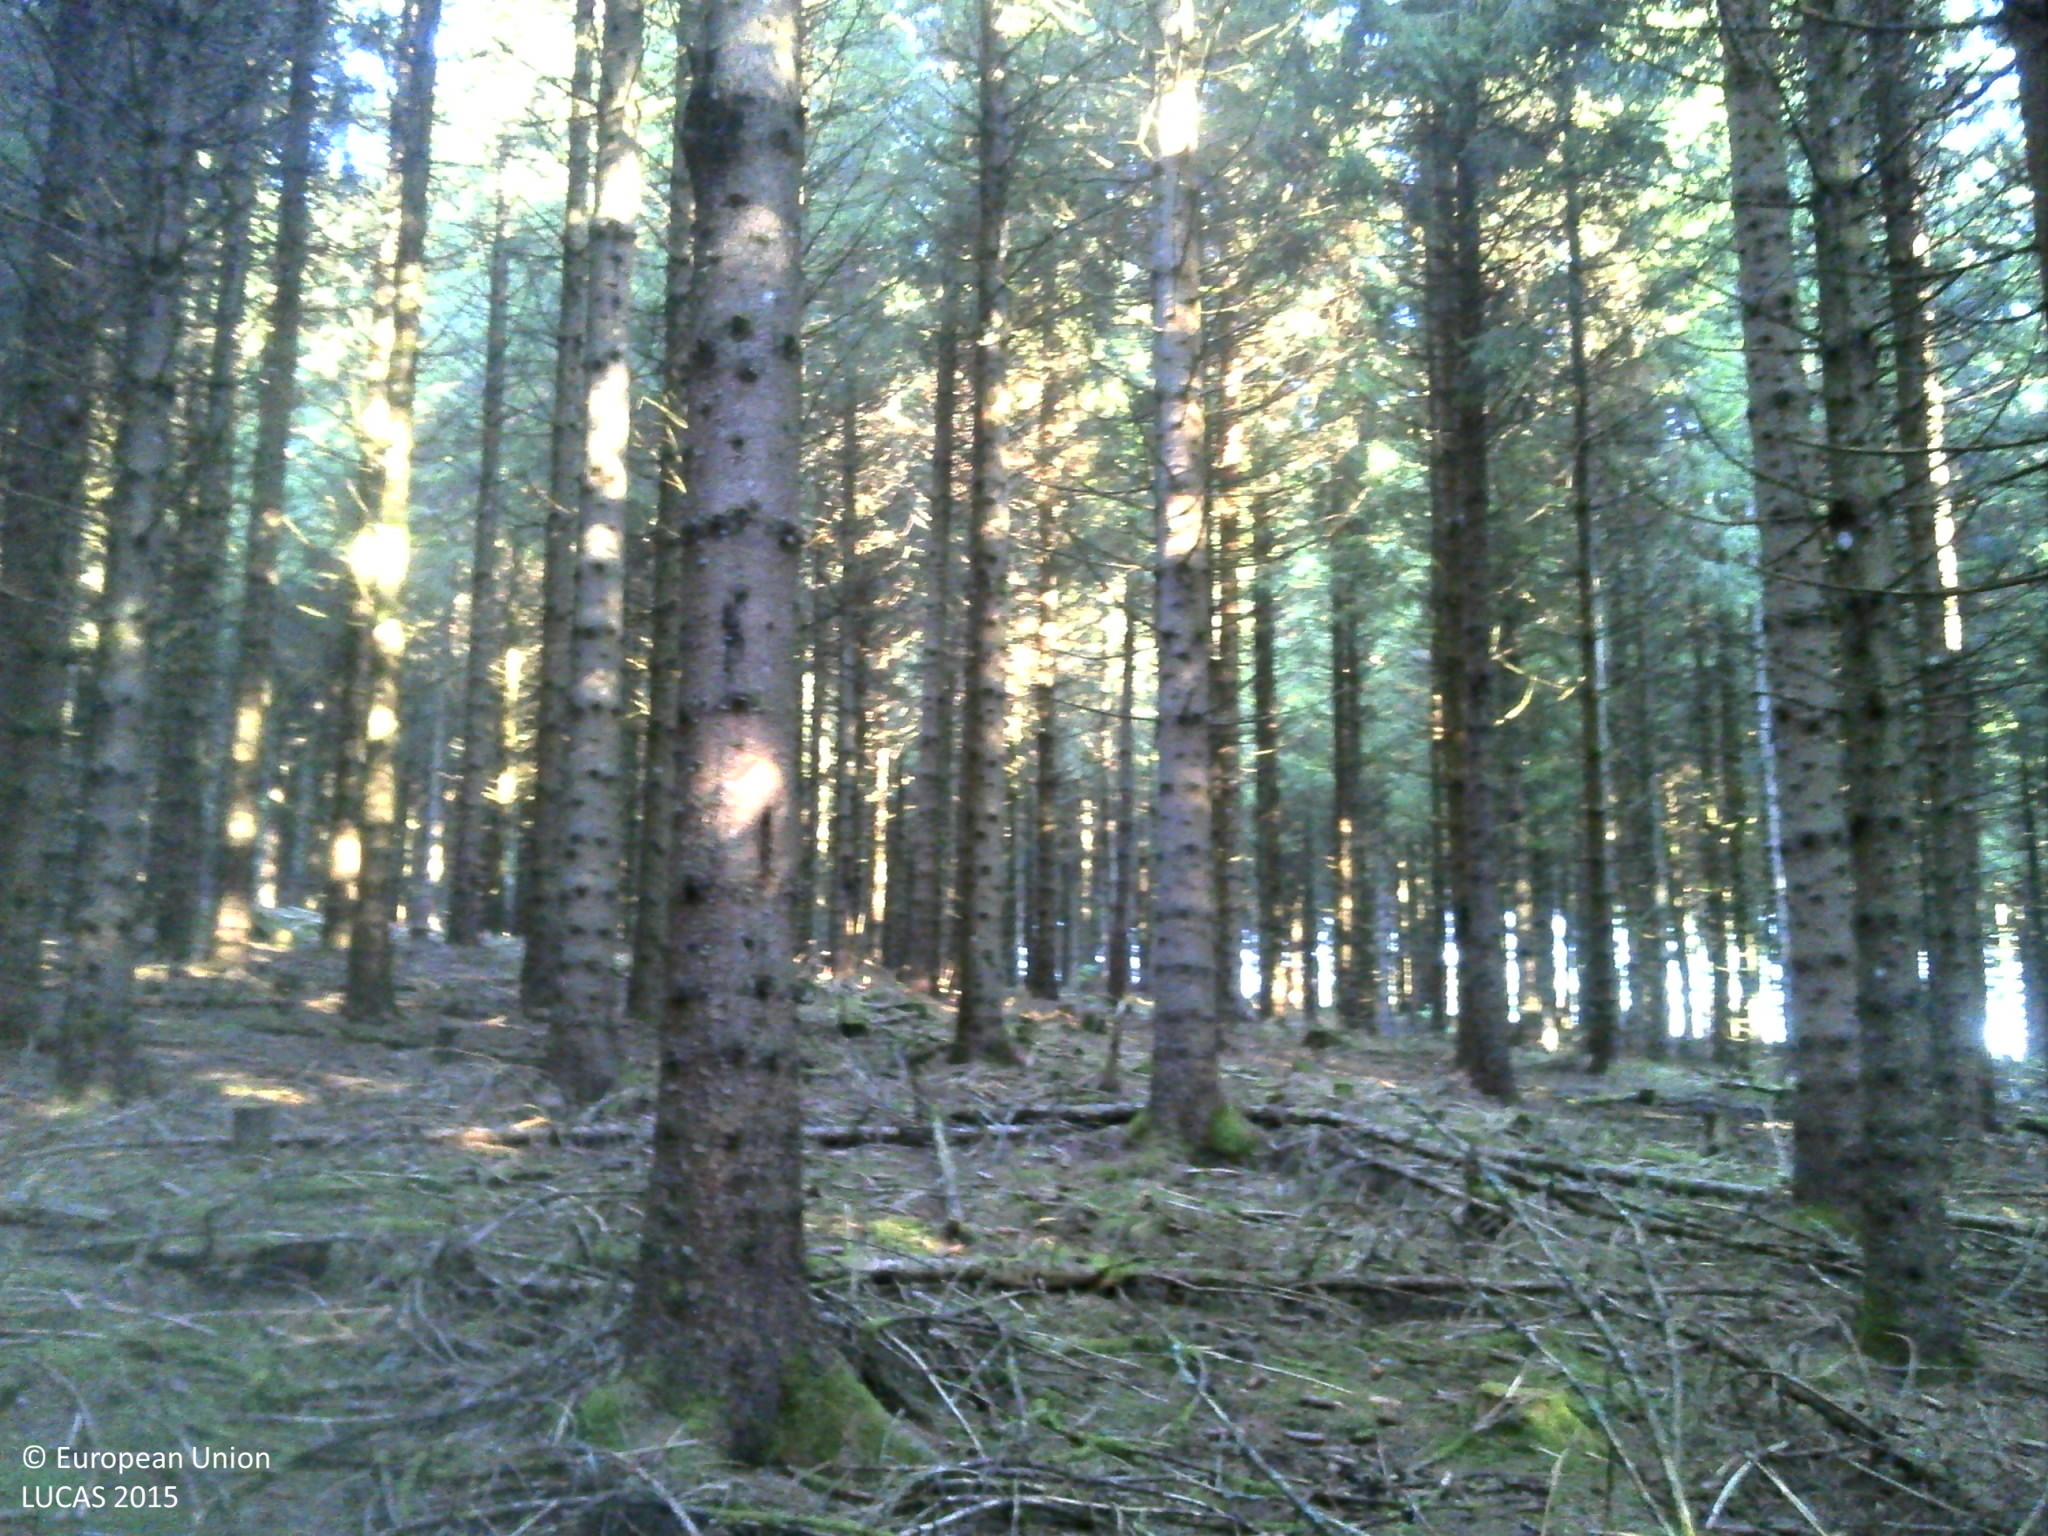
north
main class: Woodland
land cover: Spruce dominated coniferous woodland
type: exotic forest
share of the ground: > 75 %
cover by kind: coniferous forest trees 90 %, lichens and mosses 5 %, unconsolidated bare surface 5 %
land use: Forestry
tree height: > 5 m
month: October
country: FR
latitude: 45.4822
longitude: 2.8996
